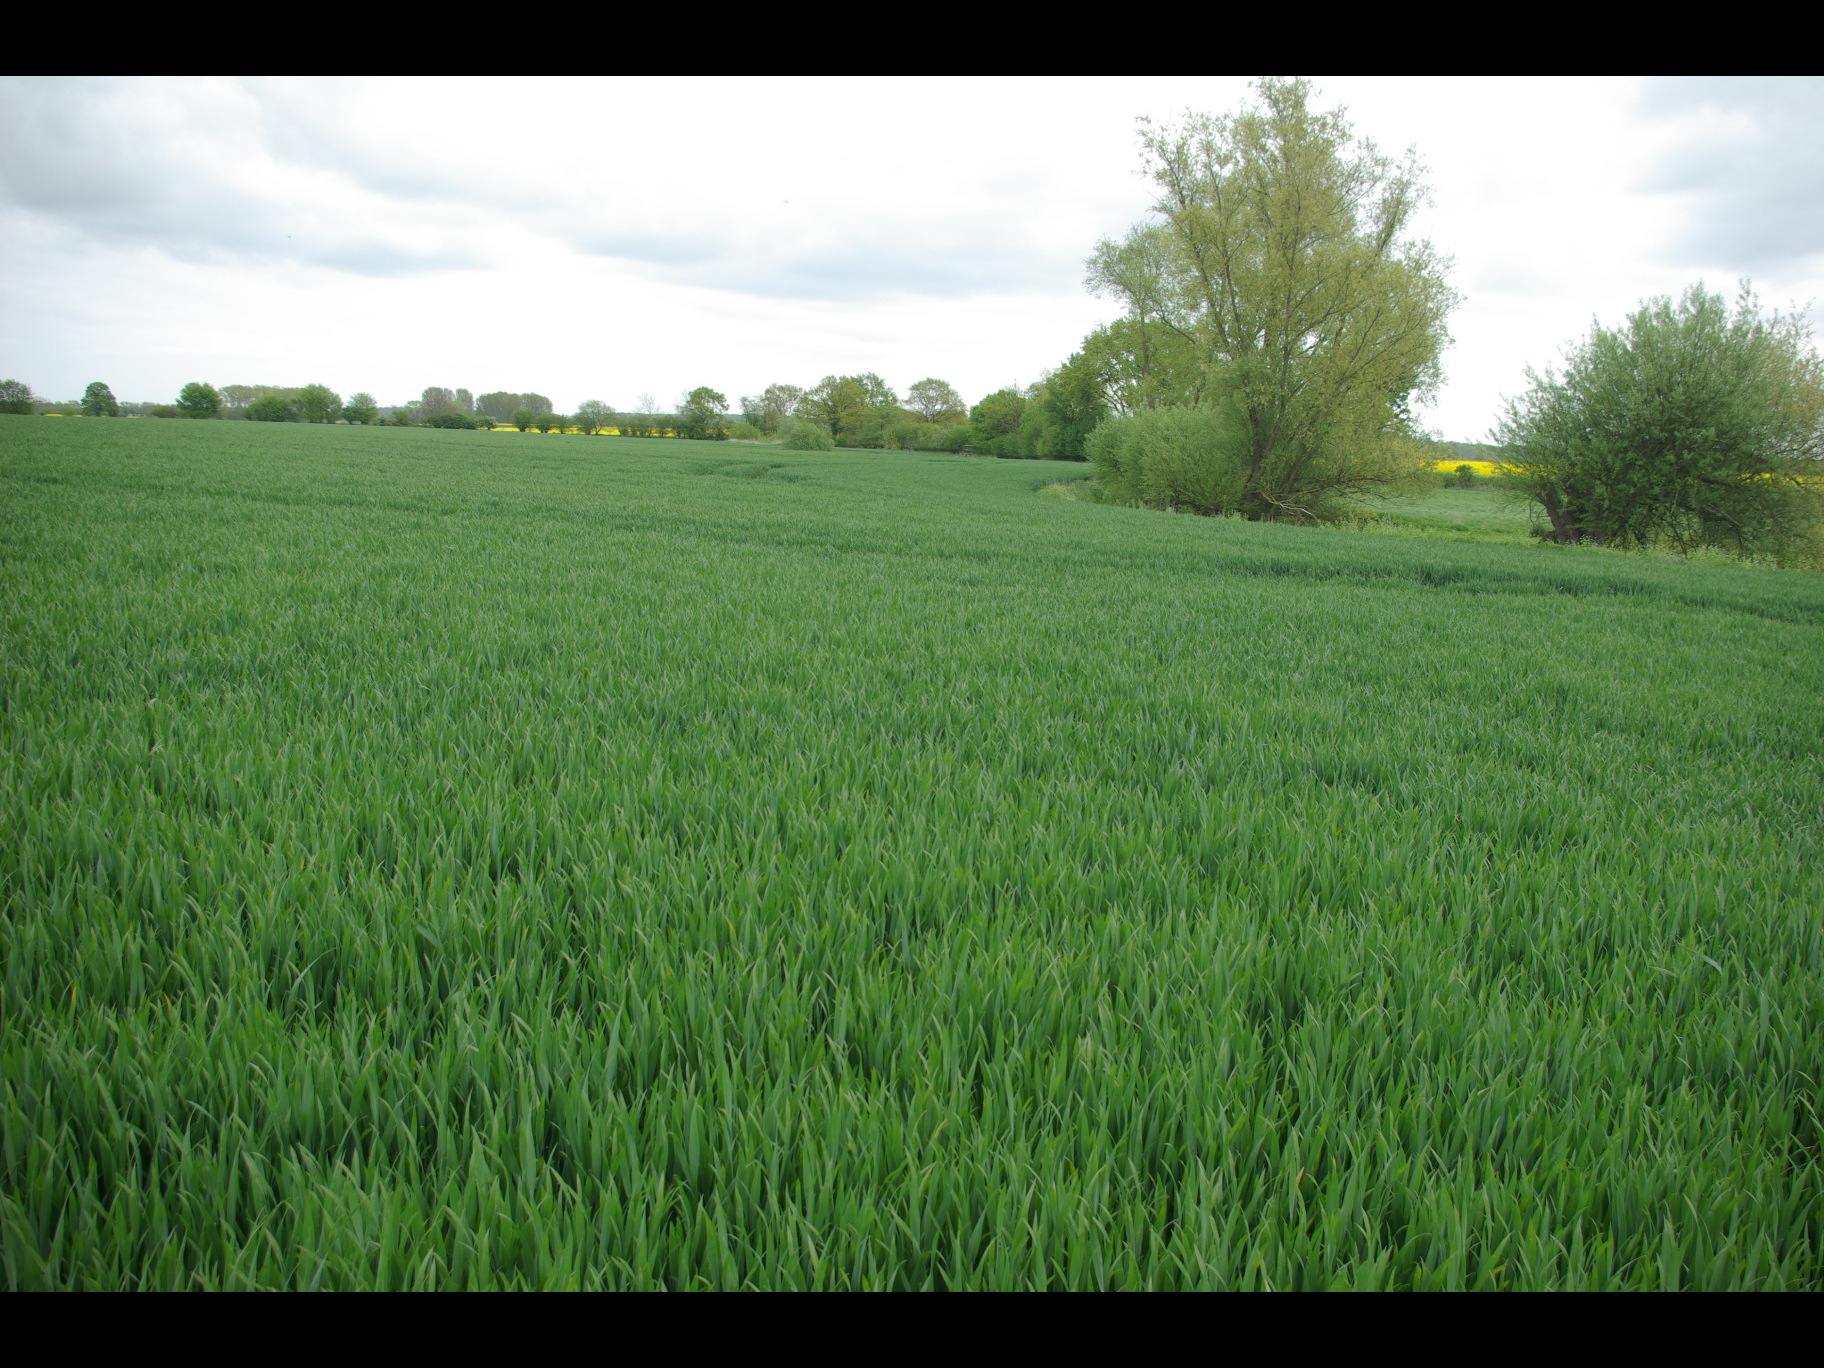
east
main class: Cropland
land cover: Common wheat
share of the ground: > 75 %
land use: Agriculture (excluding fallow land and kitchen gardens)
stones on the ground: < 10 %
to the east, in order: Common wheat; Spontaneously vegetated surfaces; Inland fresh water bodies; Spontaneously vegetated surfaces; Common wheat; Tracks; Shruby margins; Ditches and canals; Broadleaved woodland
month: May
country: DE
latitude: 54.2066
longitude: 10.9960
